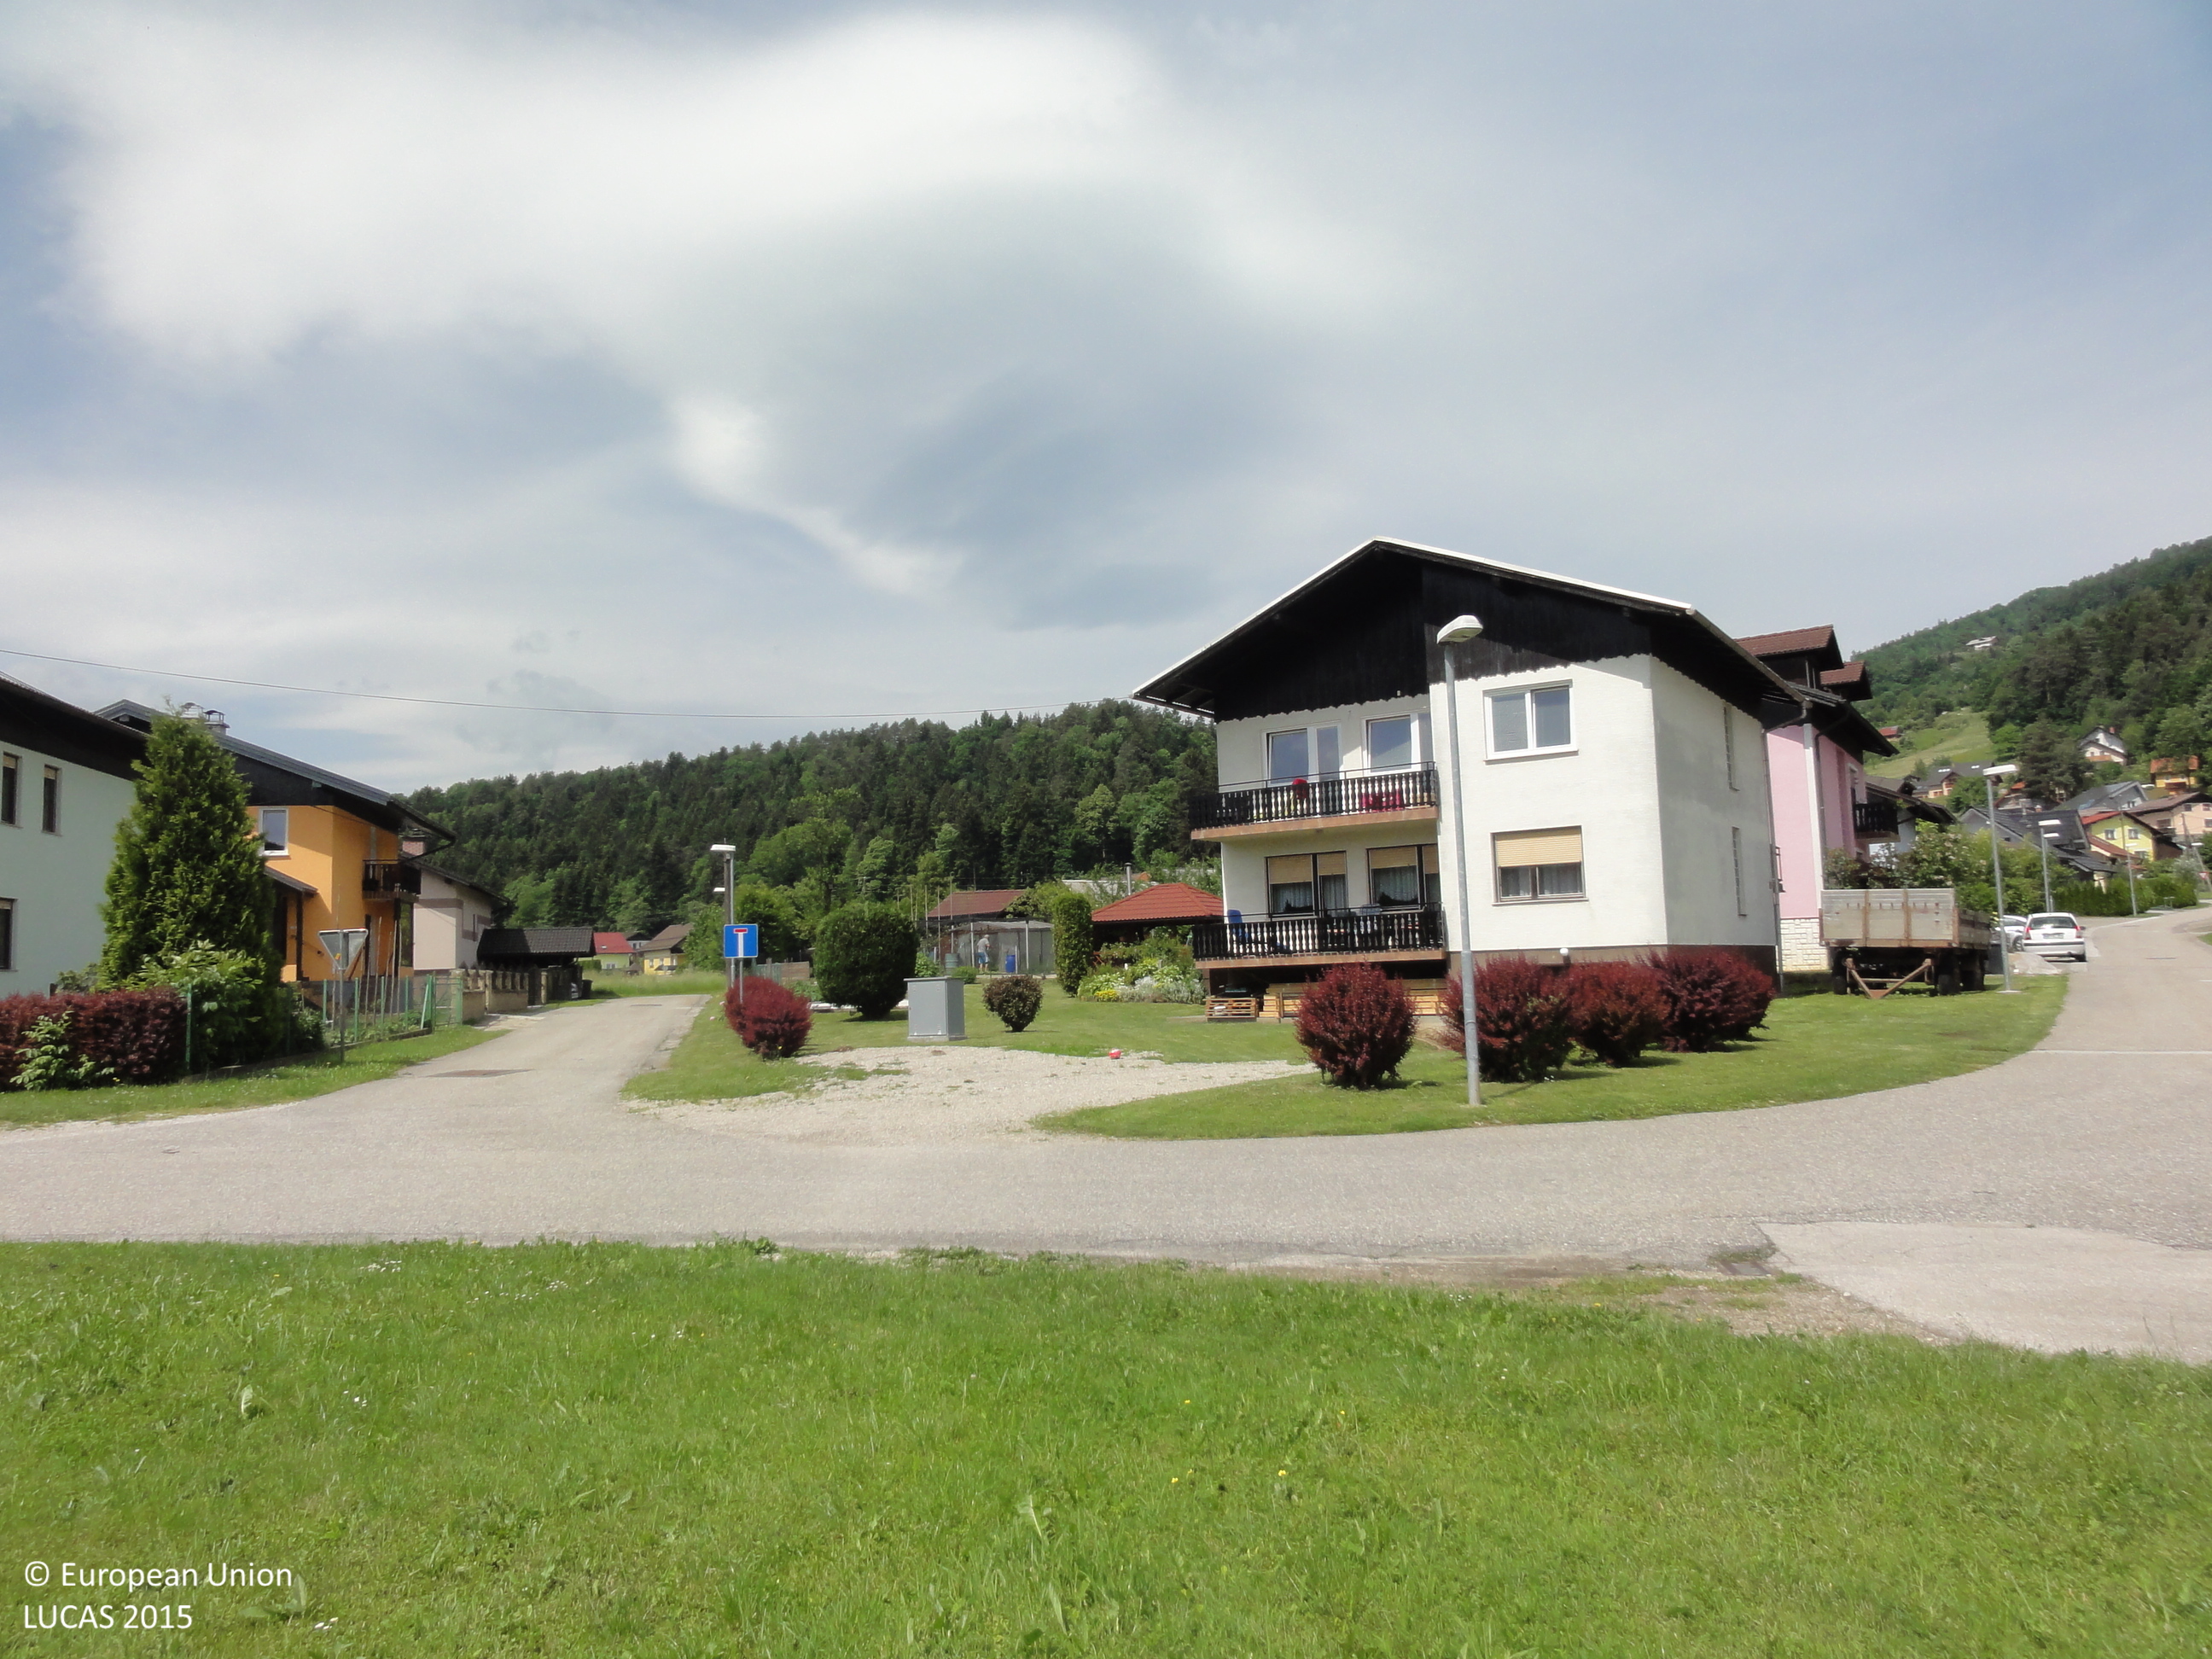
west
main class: Grassland
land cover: Grassland without tree/shrub cover
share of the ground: > 75 %
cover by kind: herbaceous plants 100 %
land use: Agriculture (excluding fallow land and kitchen gardens)
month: May
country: SI
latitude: 46.5532
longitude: 15.4899
